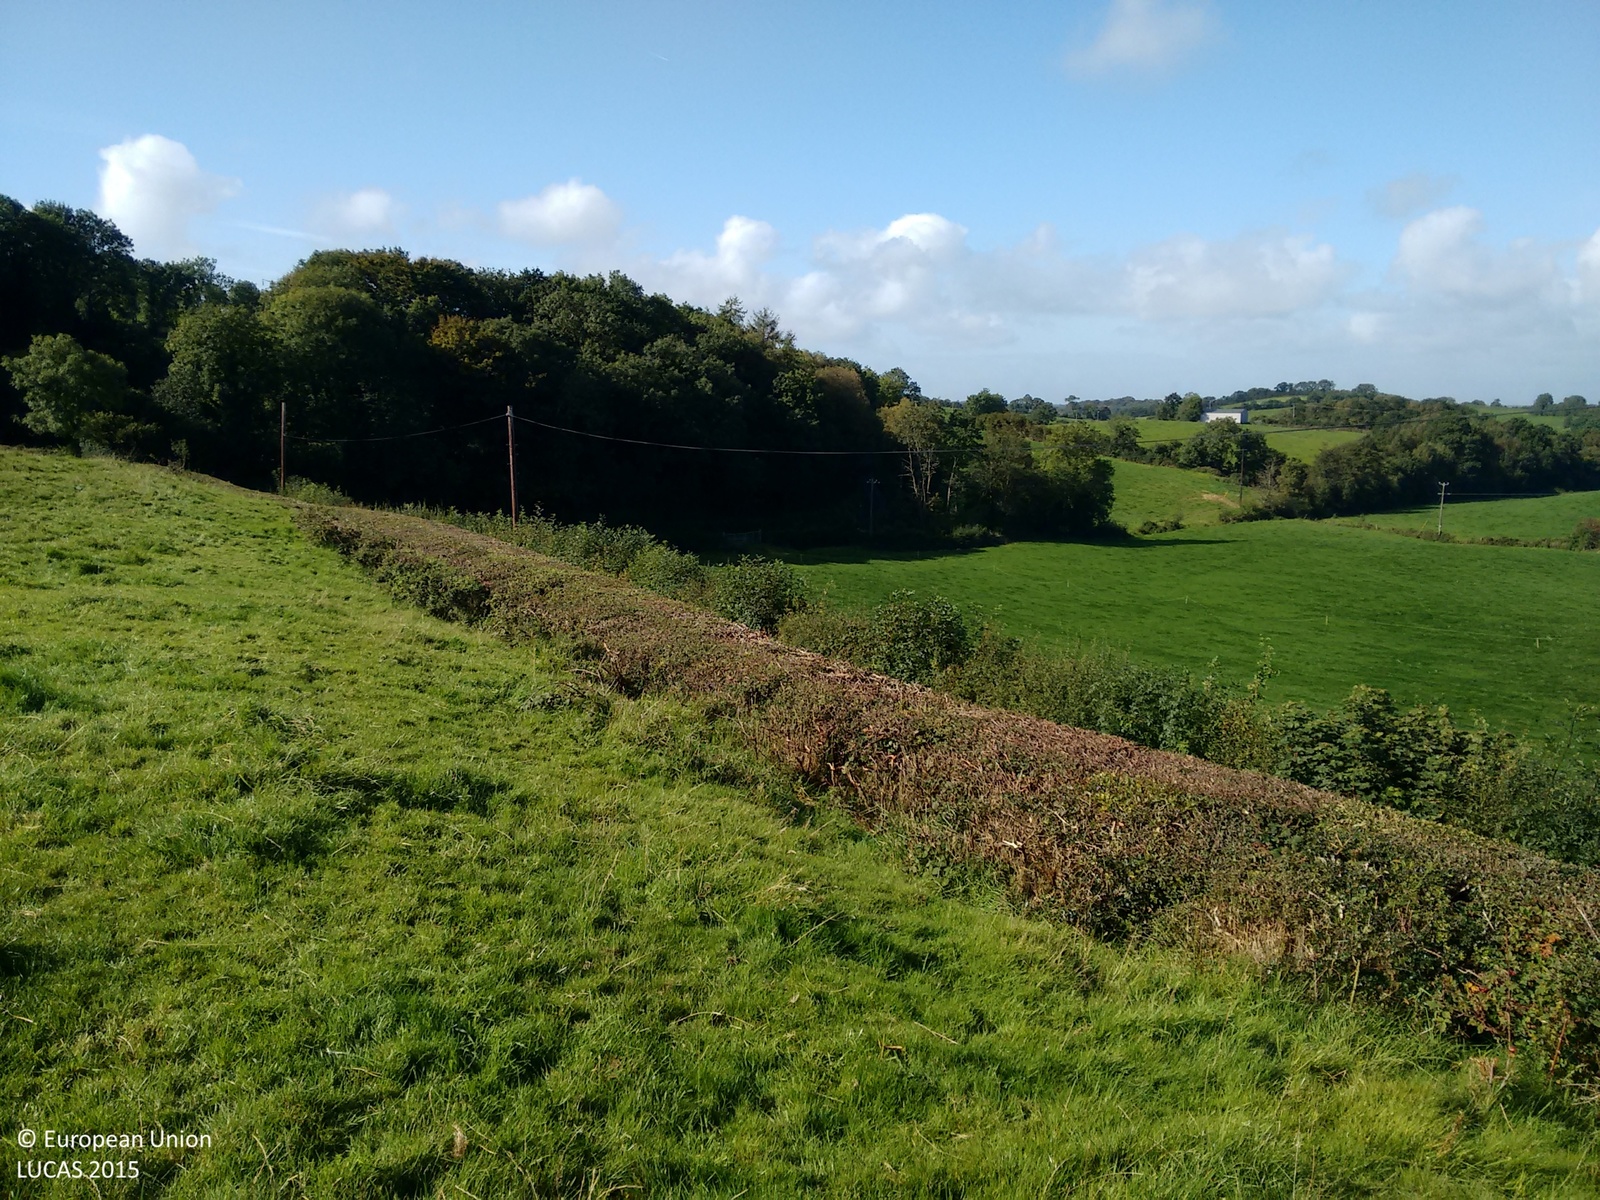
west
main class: Grassland
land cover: Grassland without tree/shrub cover
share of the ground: > 75 %
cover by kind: herbaceous plants 95 %, consolidated bare surface 5 %
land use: Agriculture (excluding fallow land and kitchen gardens)
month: September
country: IE
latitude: 54.1207
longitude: -6.8591
